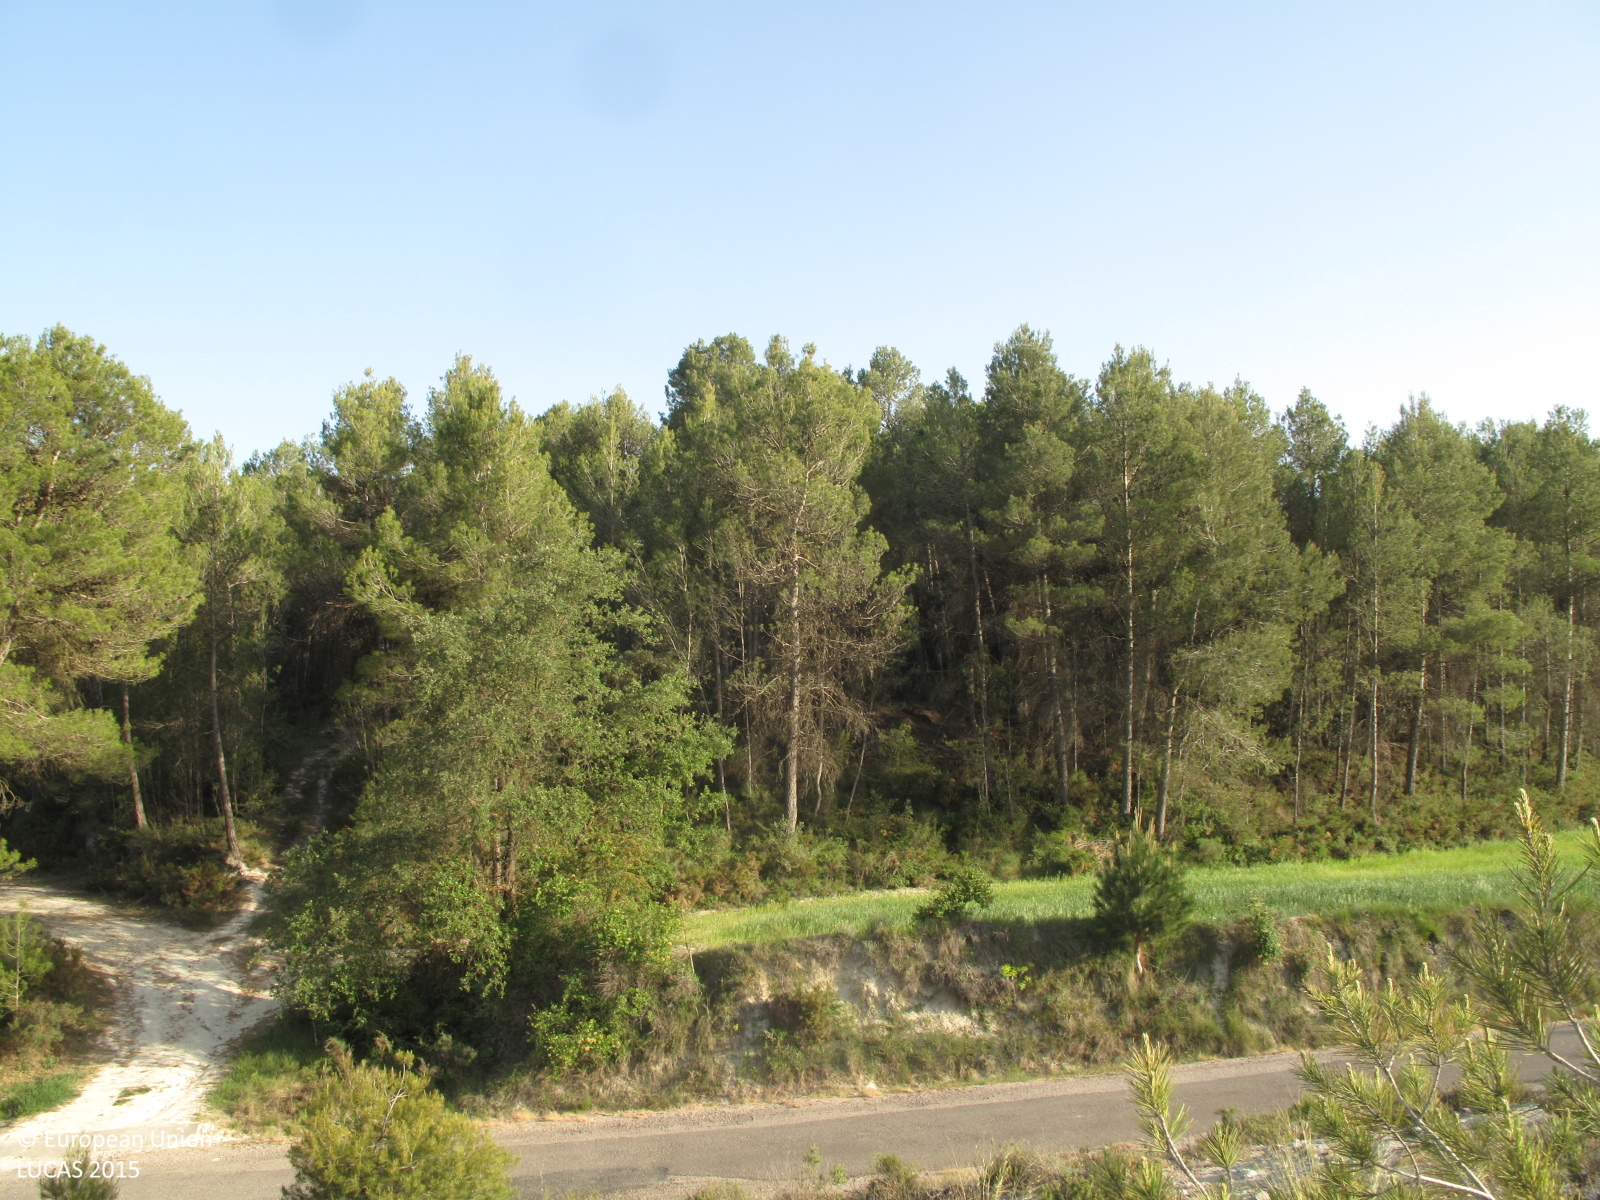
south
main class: Woodland
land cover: Pine dominated coniferous woodland
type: coniferous forest of the mediterranean region
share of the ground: 10 - 25 %
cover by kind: consolidated bare surface 50 %, coniferous forest trees 20 %, shrubs 20 %, herbaceous plants 10 %
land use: Semi-natural and natural areas not in use
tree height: < 5 m
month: May
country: ES
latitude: 38.7825
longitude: -0.5697
